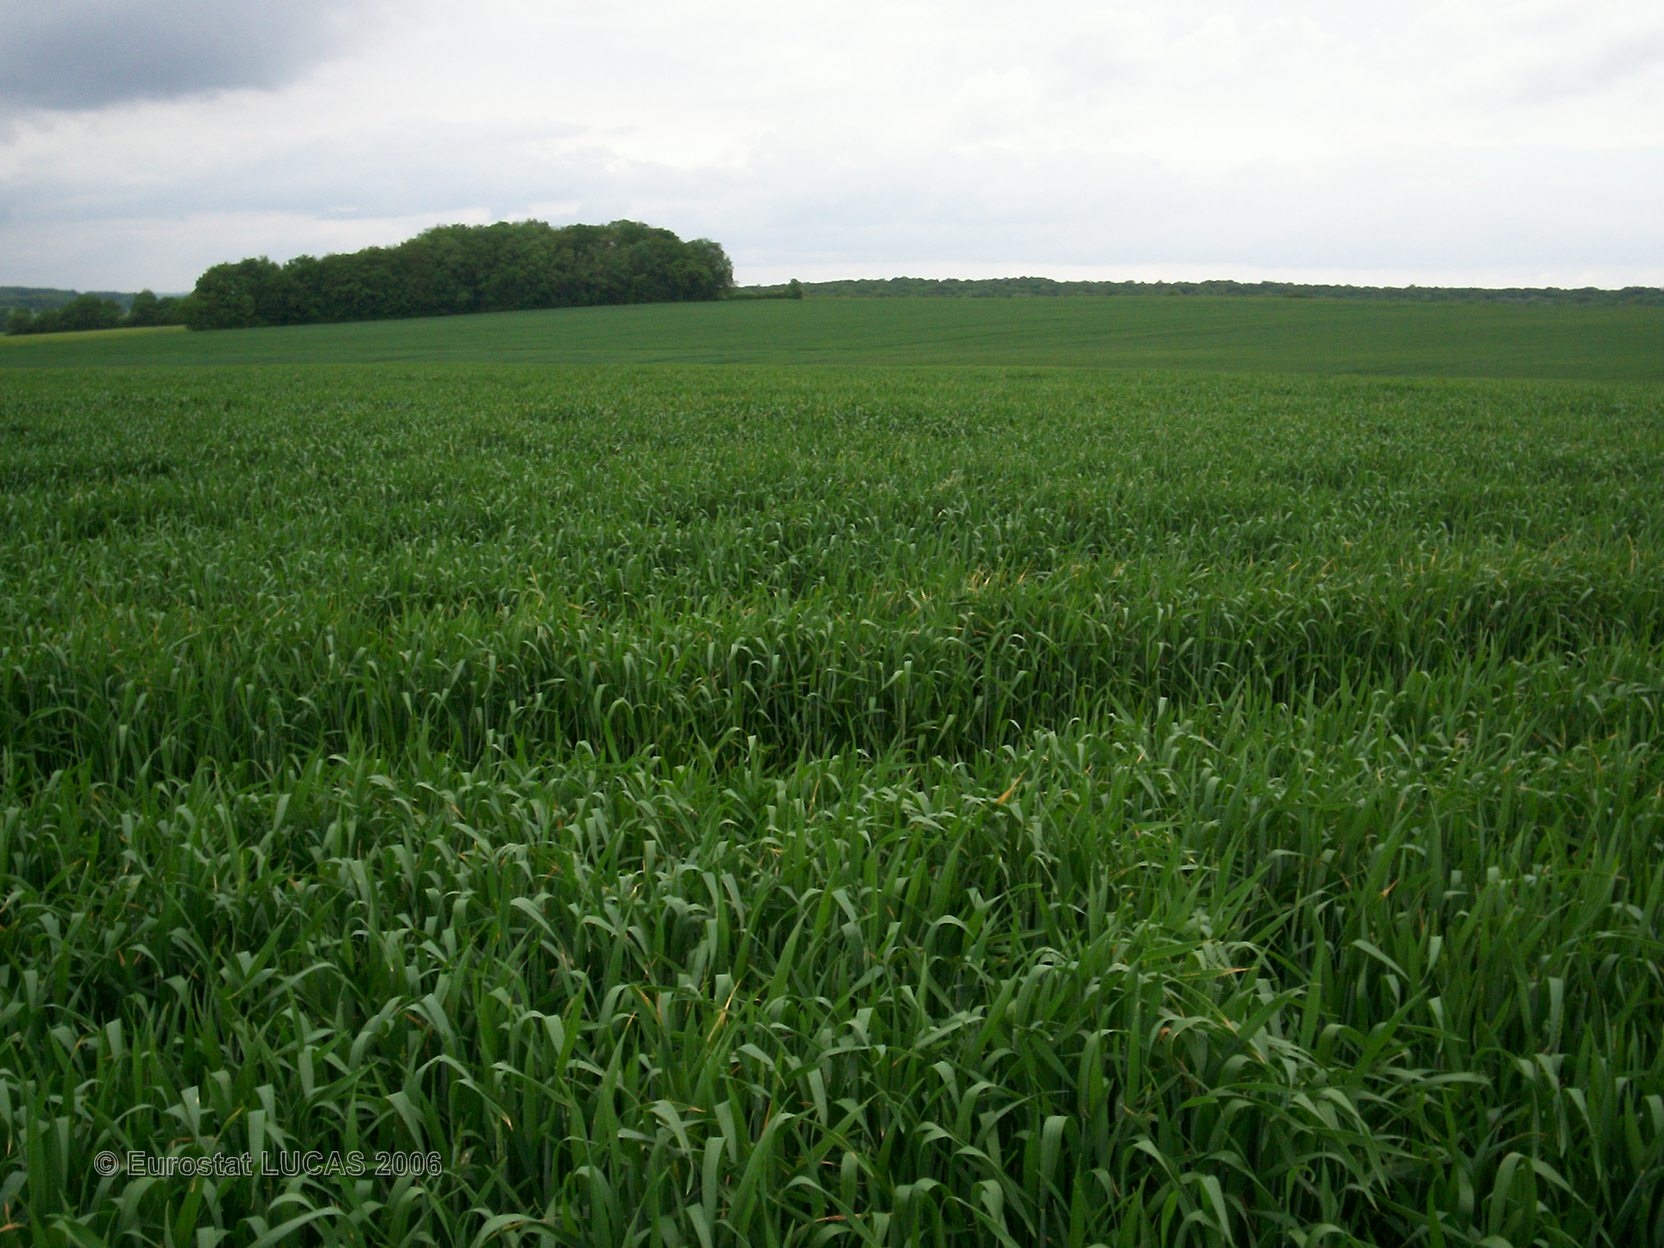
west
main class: Cropland
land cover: Common wheat
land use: Agriculture (excluding fallow land and kitchen gardens)
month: May
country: FR
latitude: 48.2467
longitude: 4.4627
